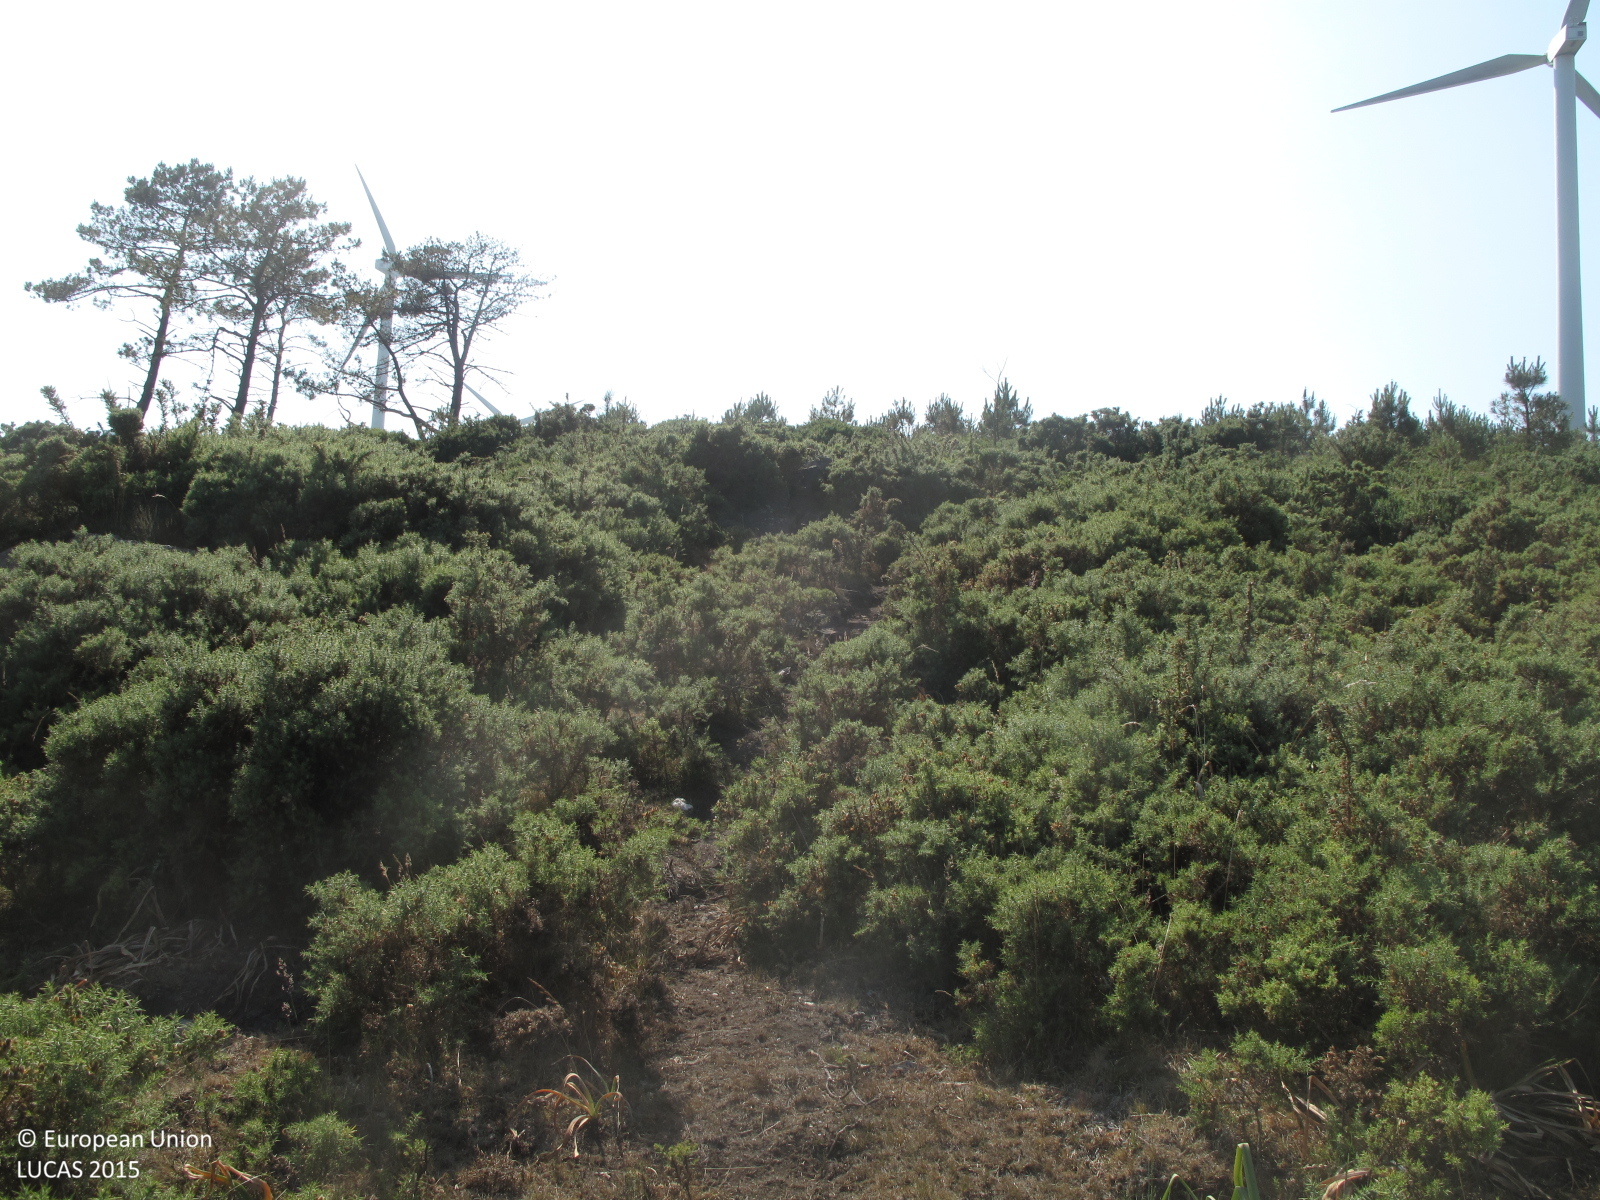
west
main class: Shrubland
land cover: Shrubland without tree cover
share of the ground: > 75 %
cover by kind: shrubs 80 %, herbaceous plants 10 %, unconsolidated bare surface 10 %
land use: Abandoned areas
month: June
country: ES
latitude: 43.2600
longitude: -7.9921
